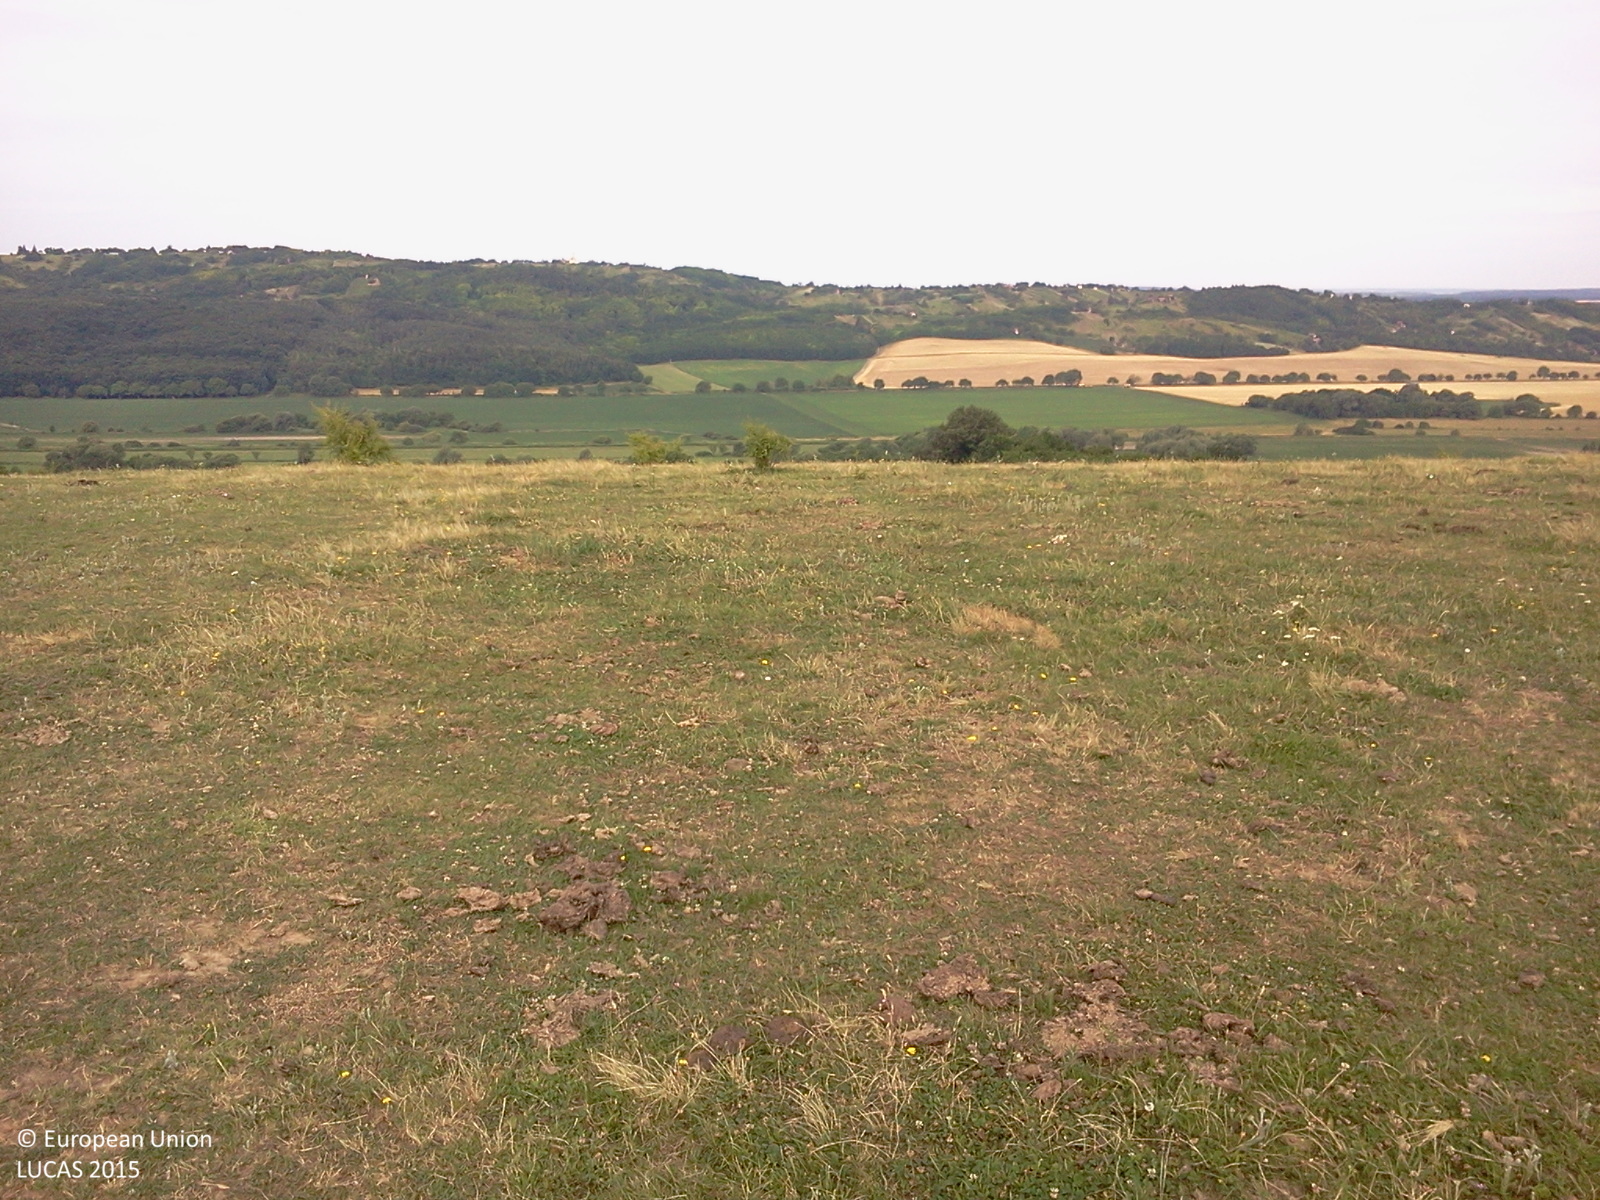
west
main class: Grassland
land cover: Grassland without tree/shrub cover
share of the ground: > 75 %
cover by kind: herbaceous plants 100 %
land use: Agriculture (excluding fallow land and kitchen gardens)
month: June
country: HU
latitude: 46.8989
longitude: 17.0004
